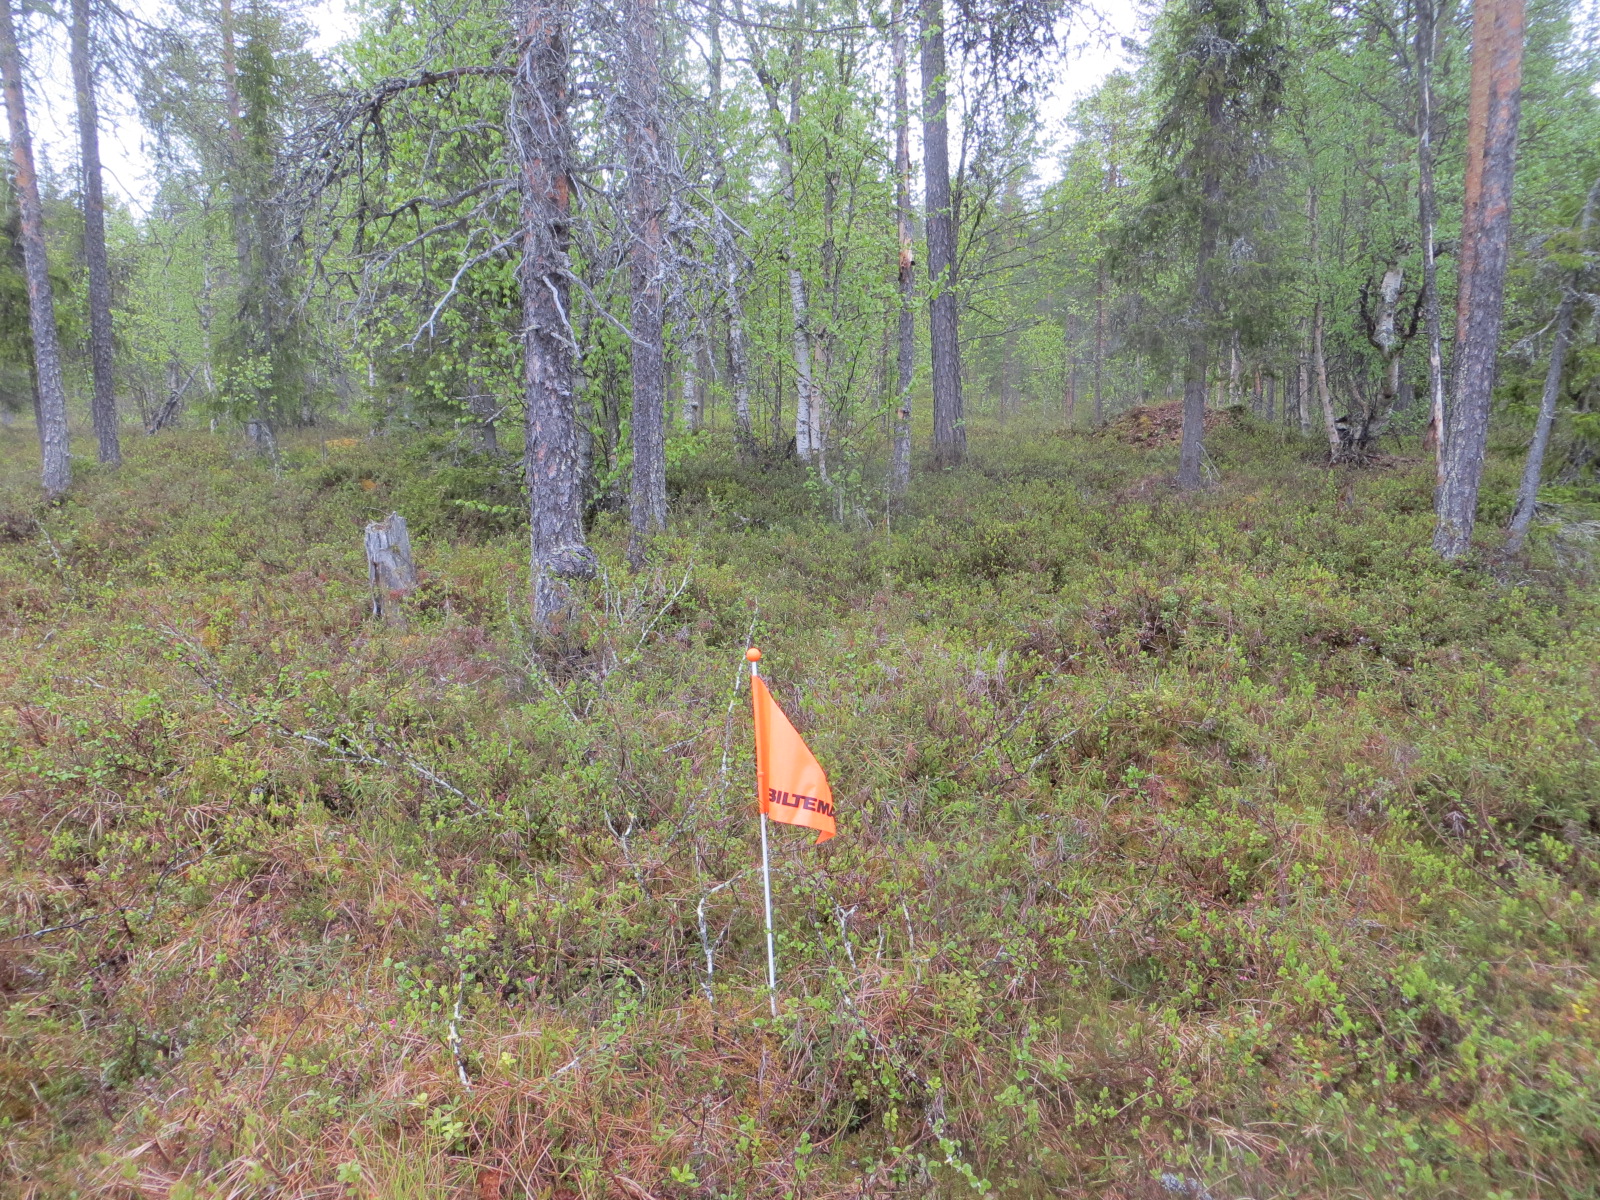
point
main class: Woodland
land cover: Other mixed woodland
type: boreal forest
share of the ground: > 75 %
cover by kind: coniferous forest trees 50 %, broadleaved forest trees 25 %, shrubs 10 %, herbaceous plants 10 %, lichens and mosses 5 %
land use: Forestry
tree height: > 5 m
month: June
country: FI
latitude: 67.2546
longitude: 25.5596
